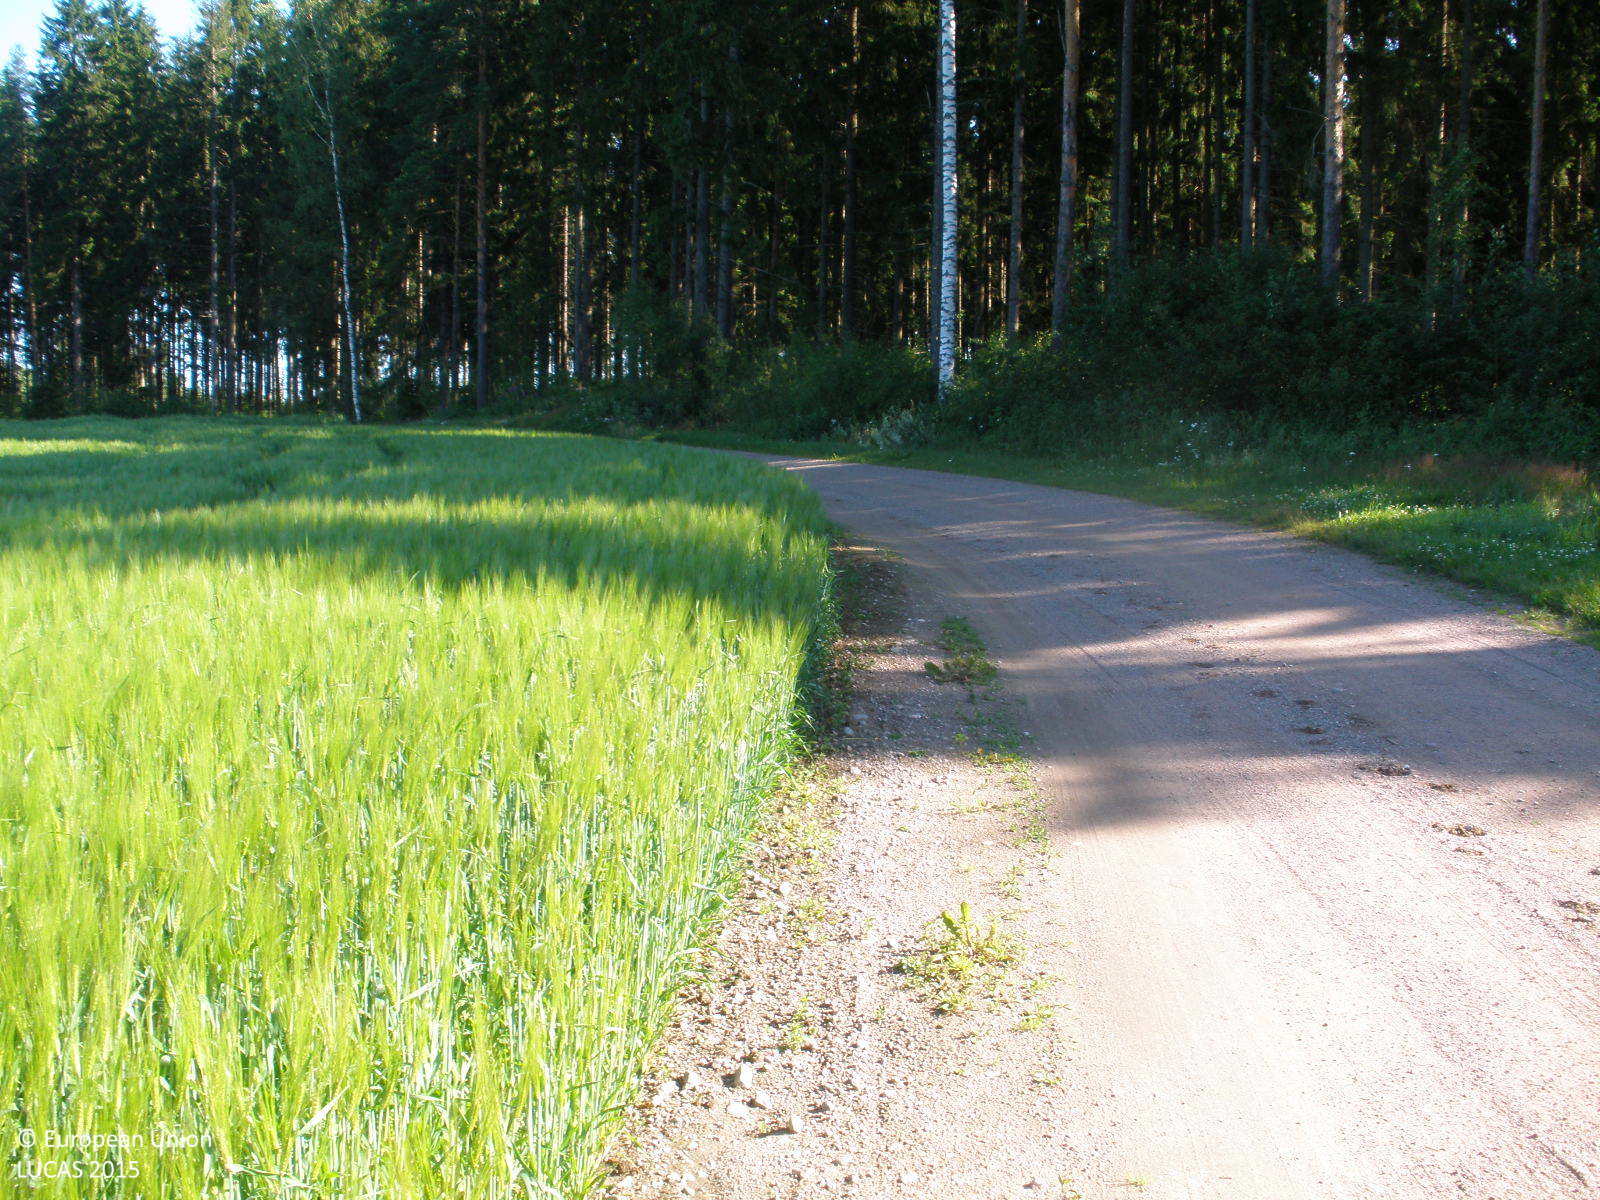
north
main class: Cropland
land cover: Barley
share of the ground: > 75 %
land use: Agriculture (excluding fallow land and kitchen gardens)
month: July
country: FI
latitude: 61.0100
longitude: 25.1548
